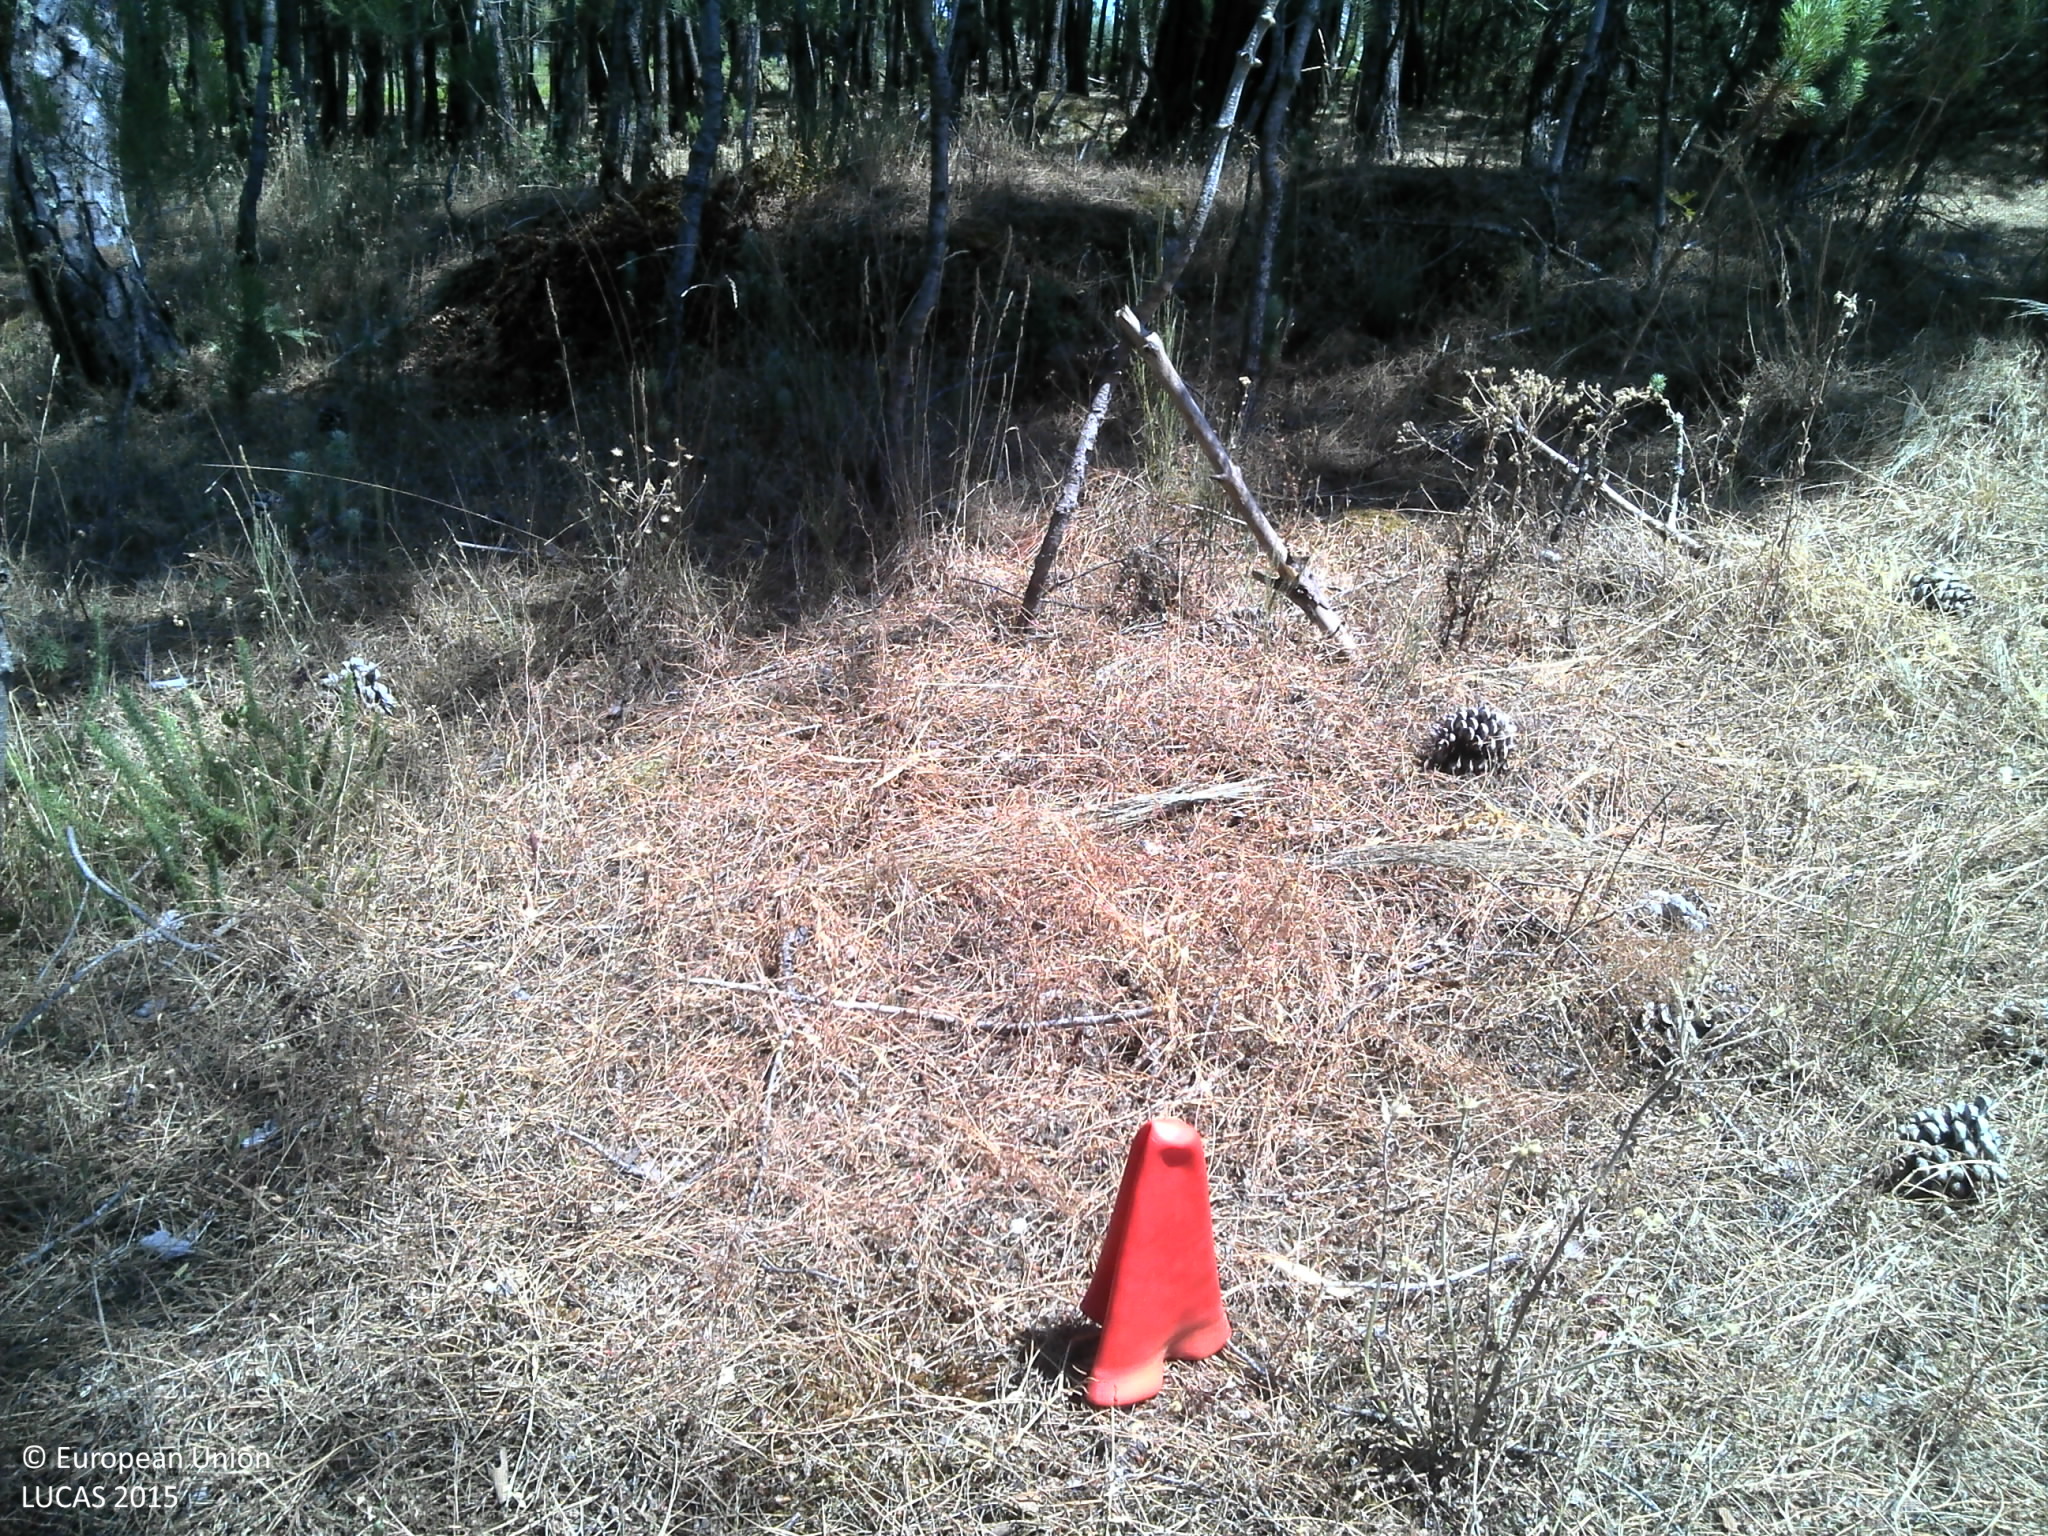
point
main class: Woodland
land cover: Pine dominated coniferous woodland
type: coniferous forest of the mediterranean region
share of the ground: 50 - 75 %
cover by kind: coniferous forest trees 60 %, unconsolidated bare surface 25 %, shrubs 10 %, herbaceous plants 5 %
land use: Forestry
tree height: > 5 m
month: July
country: PT
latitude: 40.3939
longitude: -7.9215
